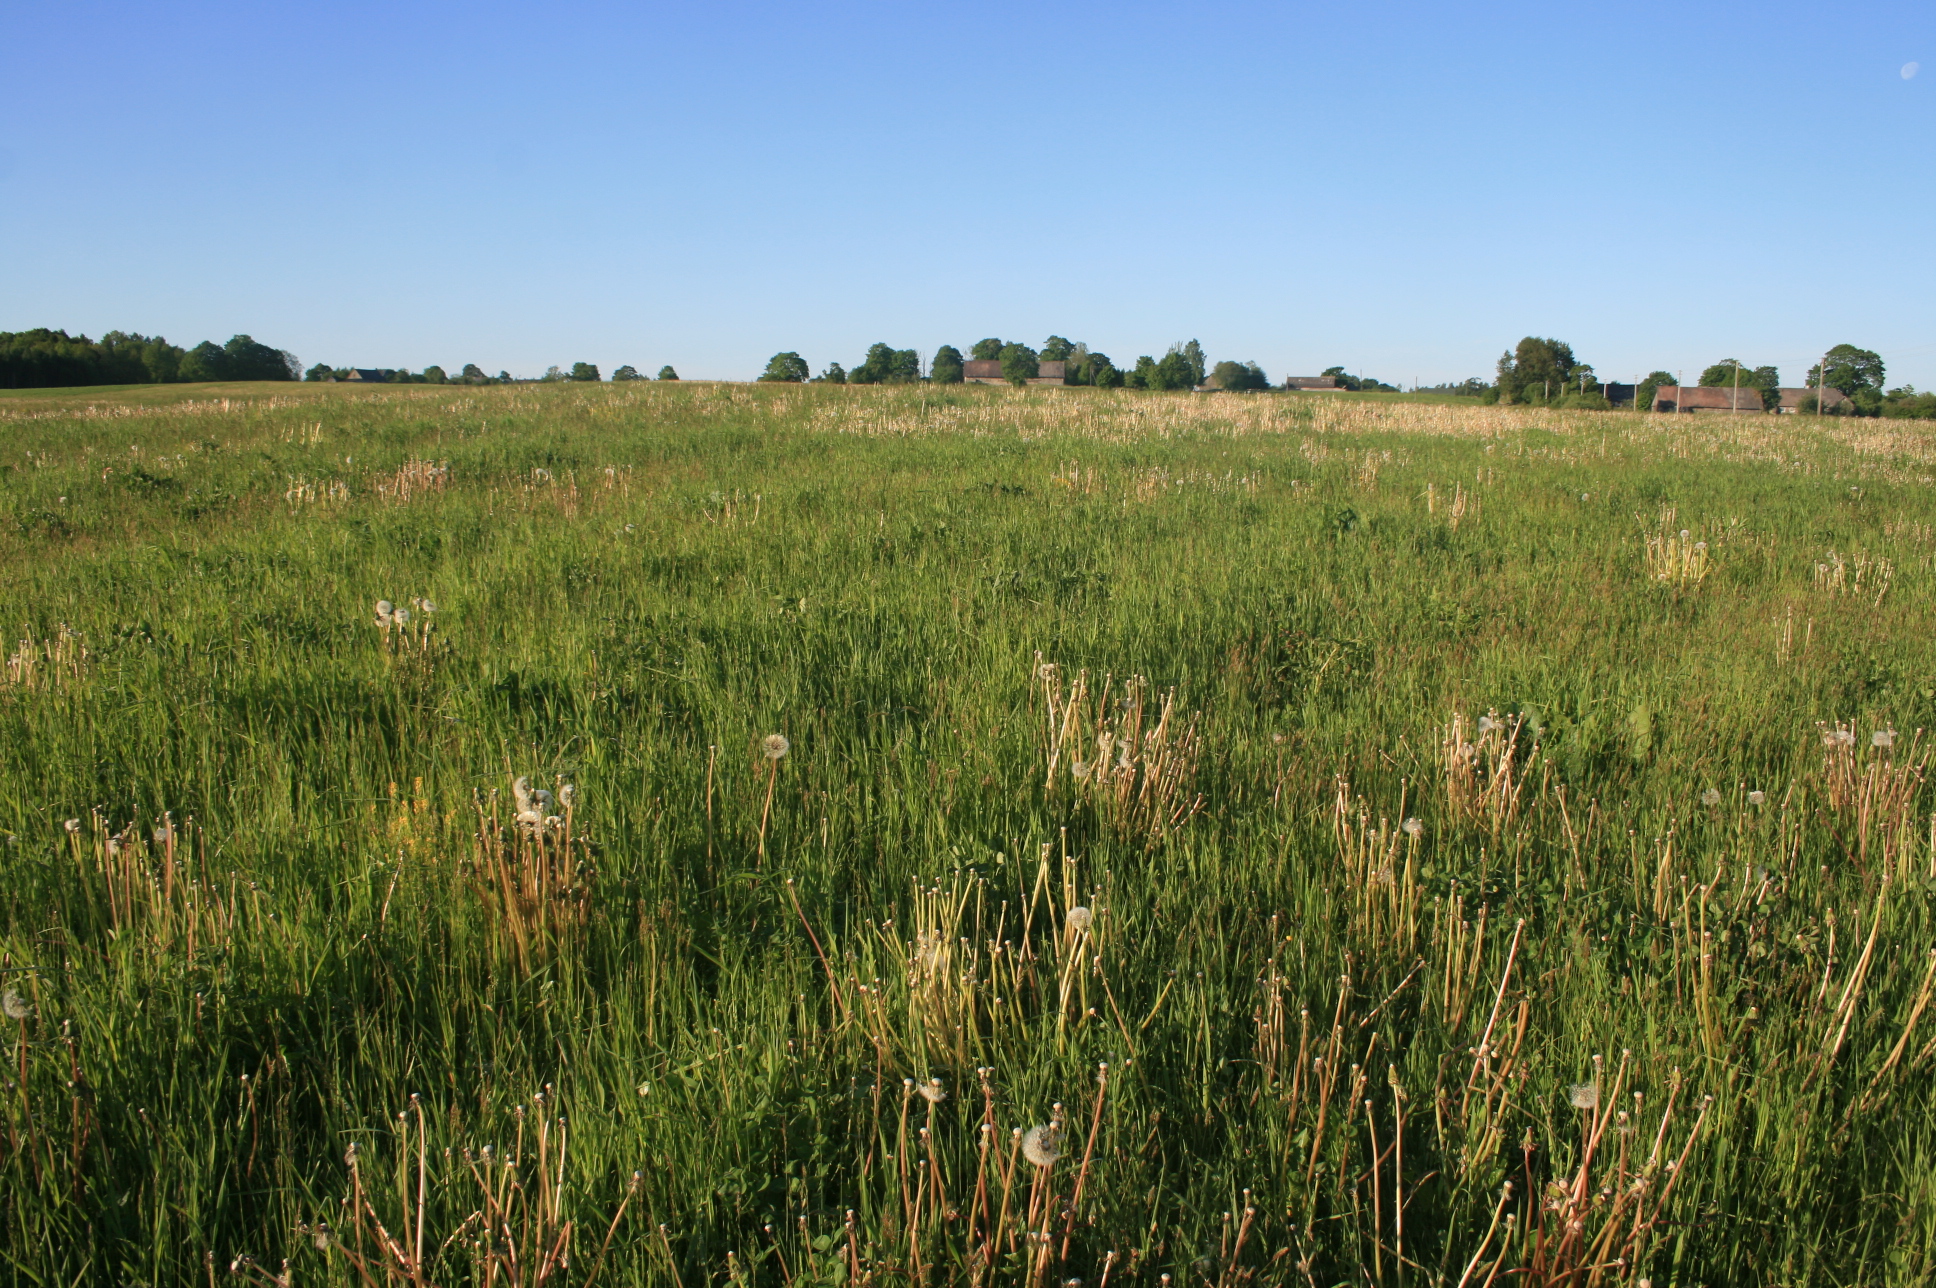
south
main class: Grassland
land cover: Grassland without tree/shrub cover
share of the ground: > 75 %
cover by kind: herbaceous plants 100 %
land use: Agriculture (excluding fallow land and kitchen gardens)
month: June
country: LT
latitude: 55.8984
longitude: 21.9658
